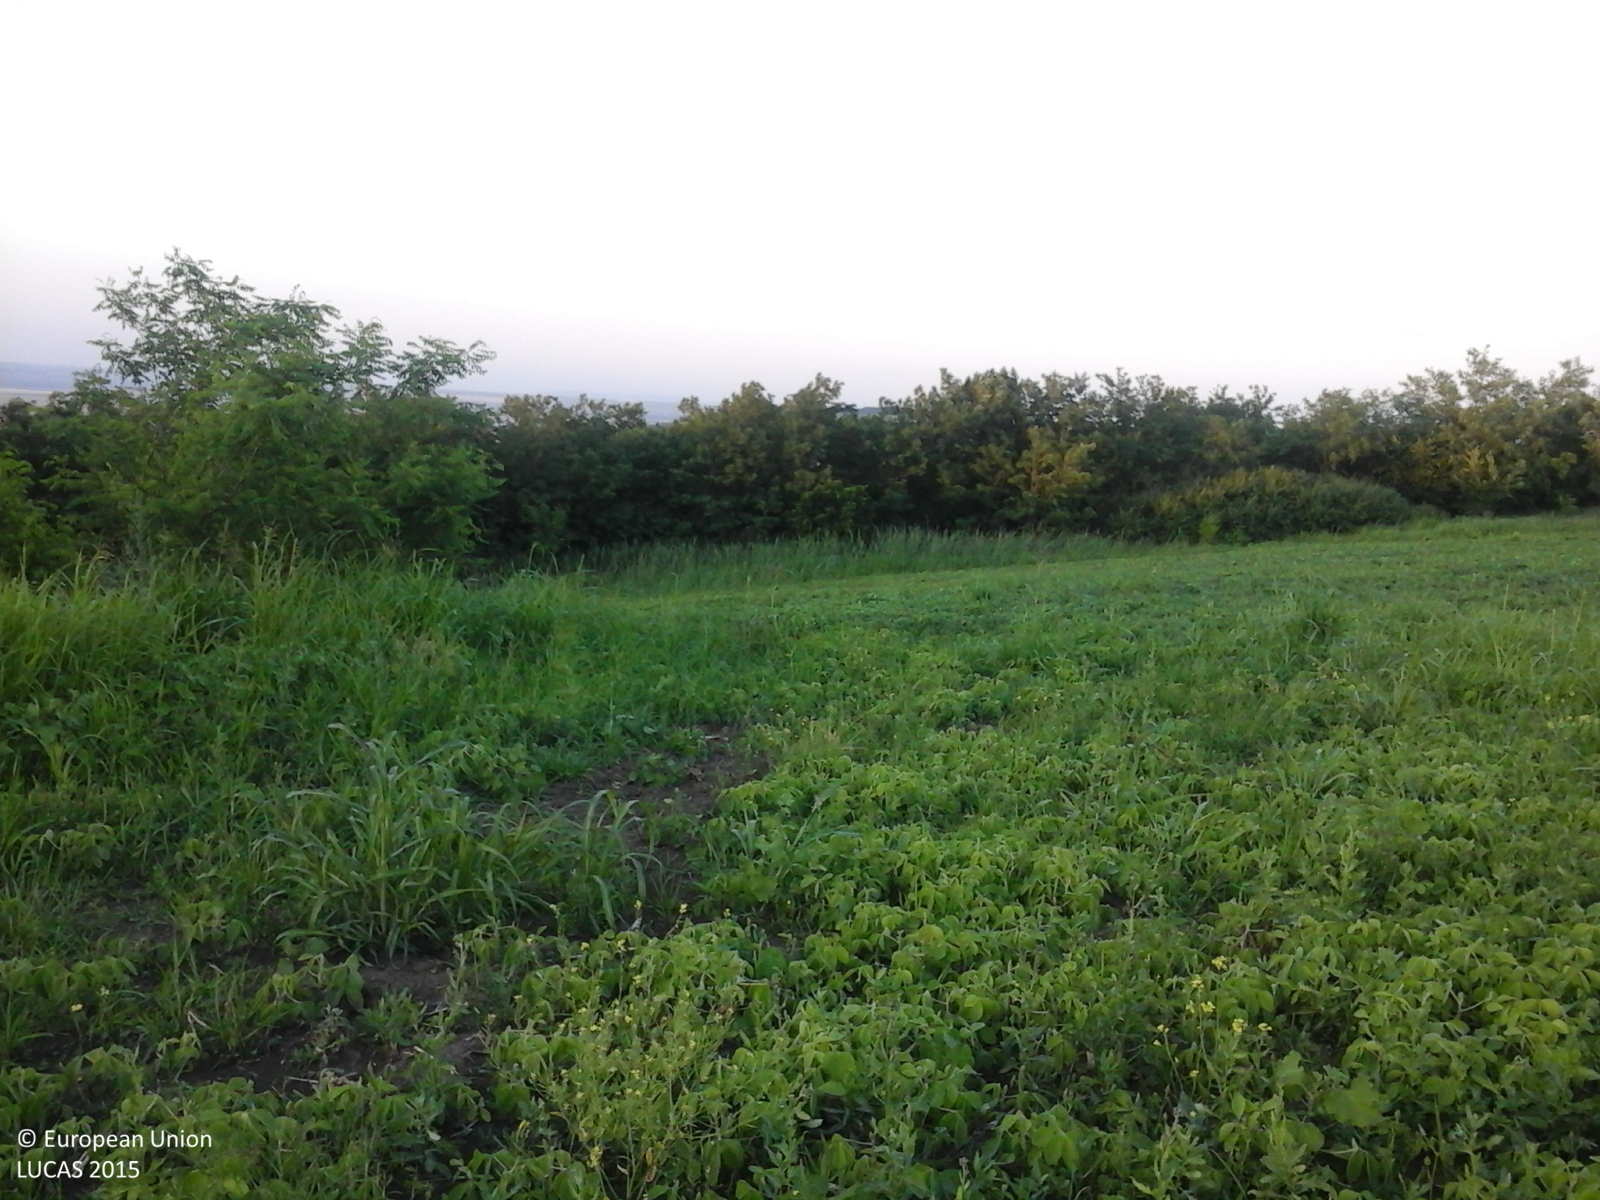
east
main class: Cropland
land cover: Soya
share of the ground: > 75 %
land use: Agriculture (excluding fallow land and kitchen gardens)
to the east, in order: Soya; Spontaneously vegetated surfaces; Broadleaved woodland
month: June
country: RO
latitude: 47.2912
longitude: 27.4779
